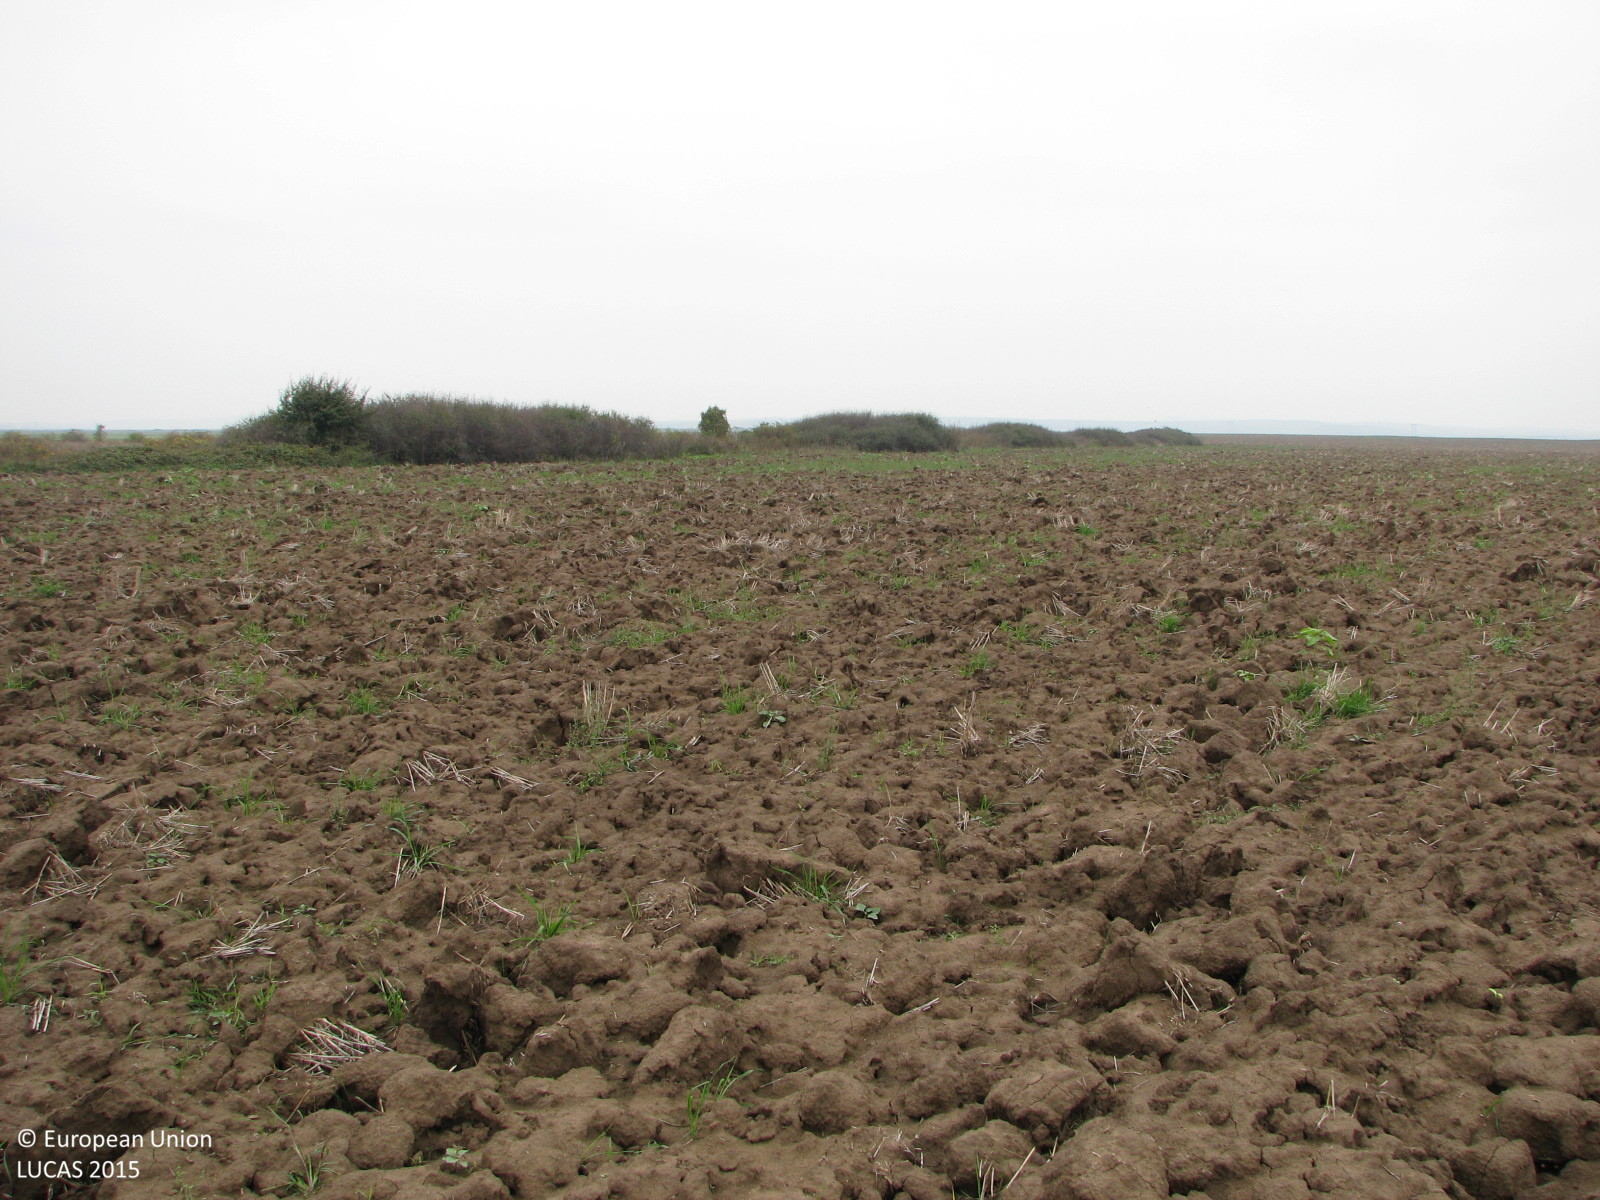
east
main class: Cropland
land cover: Common wheat
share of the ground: < 10 %
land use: Agriculture (excluding fallow land and kitchen gardens)
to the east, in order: Common wheat; Shrubland without tree cover; Grass margins; Tracks; Grass margins; Rape and turnip rape
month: October
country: BG
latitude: 42.5896
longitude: 26.7579
